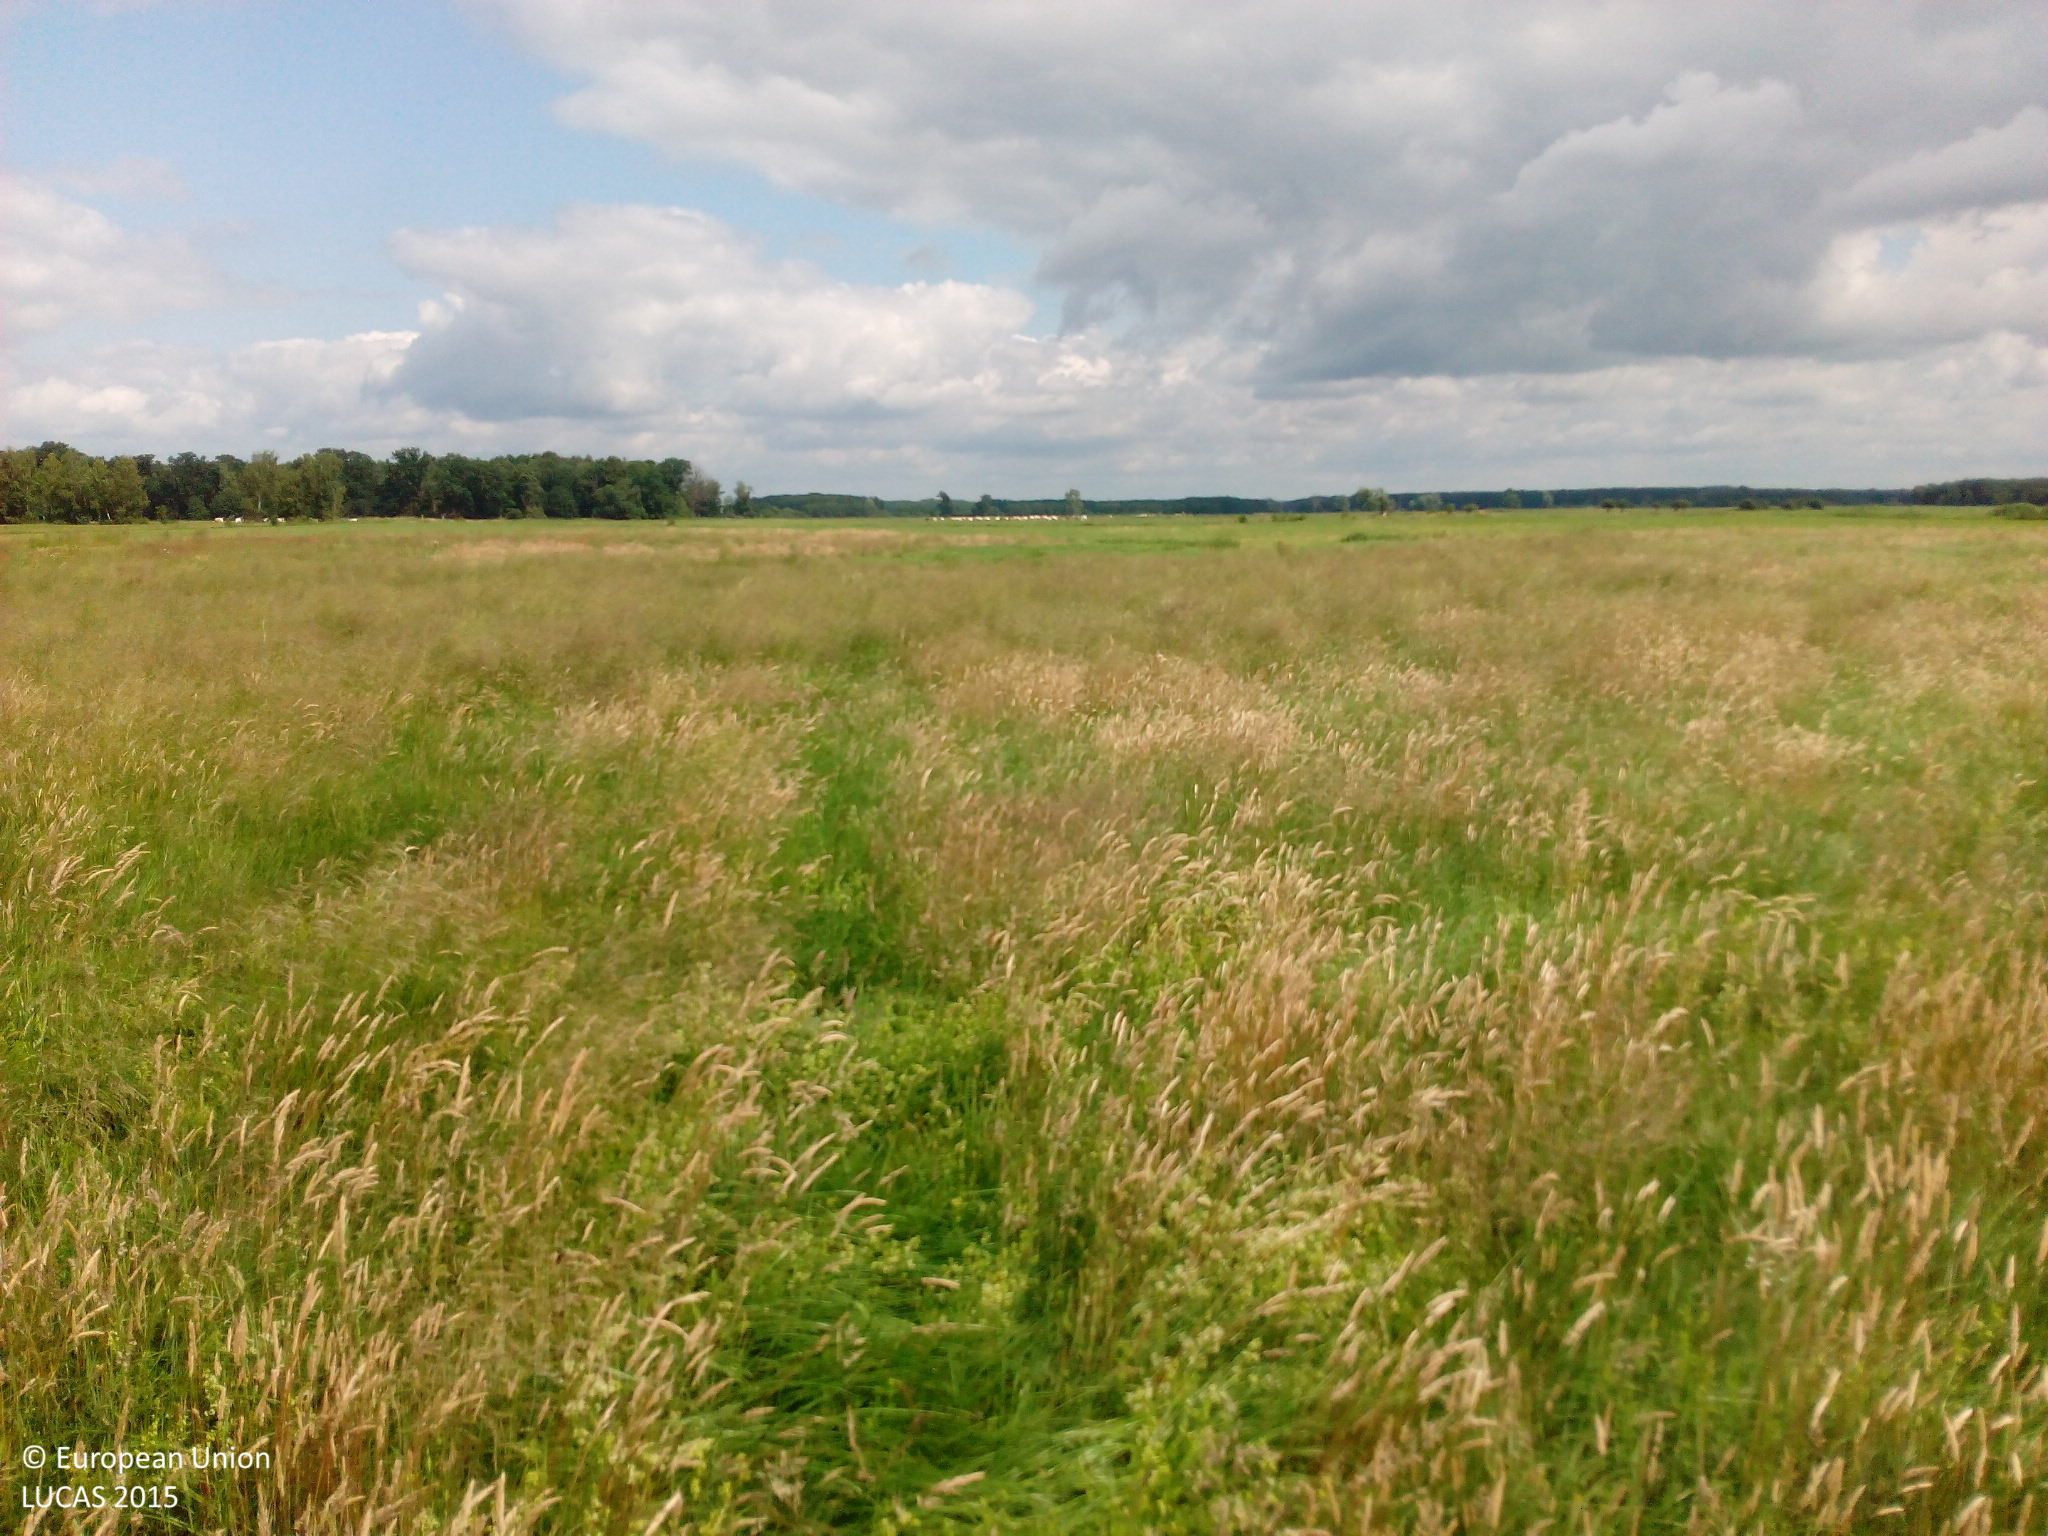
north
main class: Grassland
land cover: Grassland without tree/shrub cover
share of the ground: > 75 %
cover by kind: herbaceous plants 100 %
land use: Agriculture (excluding fallow land and kitchen gardens)
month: July
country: DE
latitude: 52.6941
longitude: 12.4409
